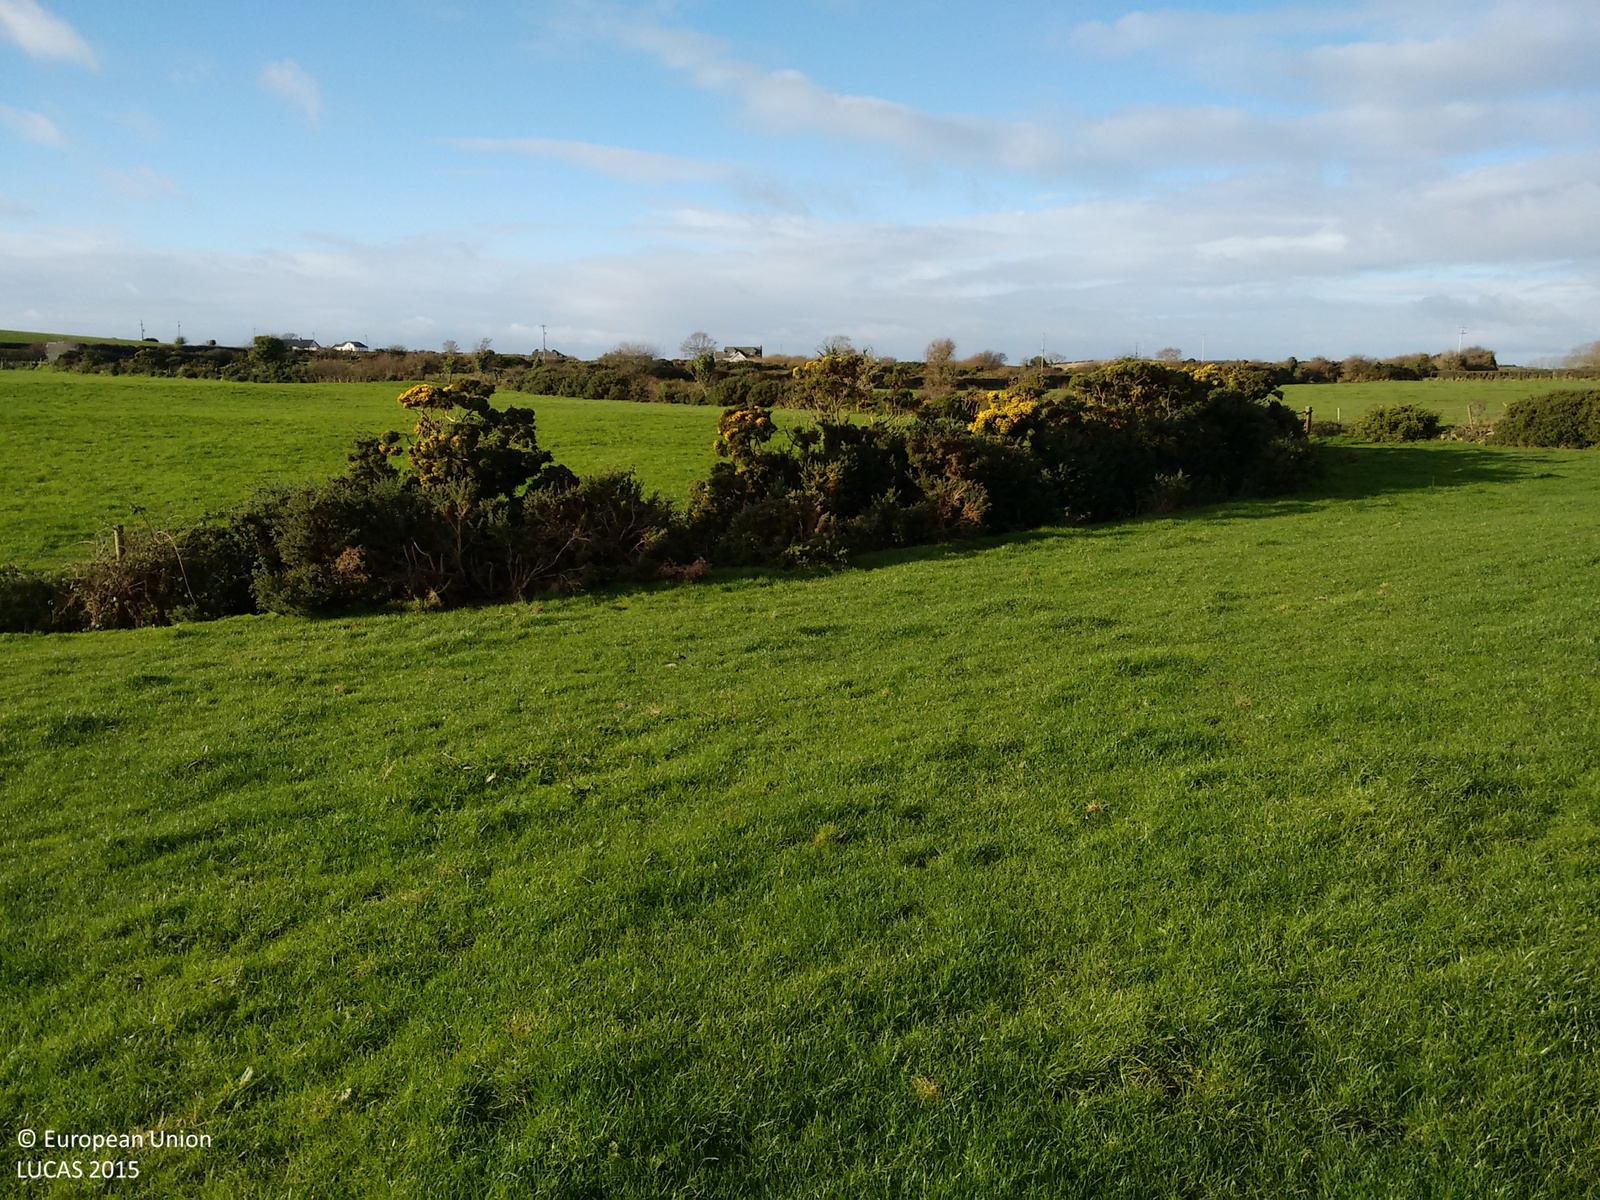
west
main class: Grassland
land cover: Grassland without tree/shrub cover
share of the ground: > 75 %
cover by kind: herbaceous plants 100 %
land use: Agriculture (excluding fallow land and kitchen gardens)
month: November
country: GB
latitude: 54.4269
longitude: -5.5267
